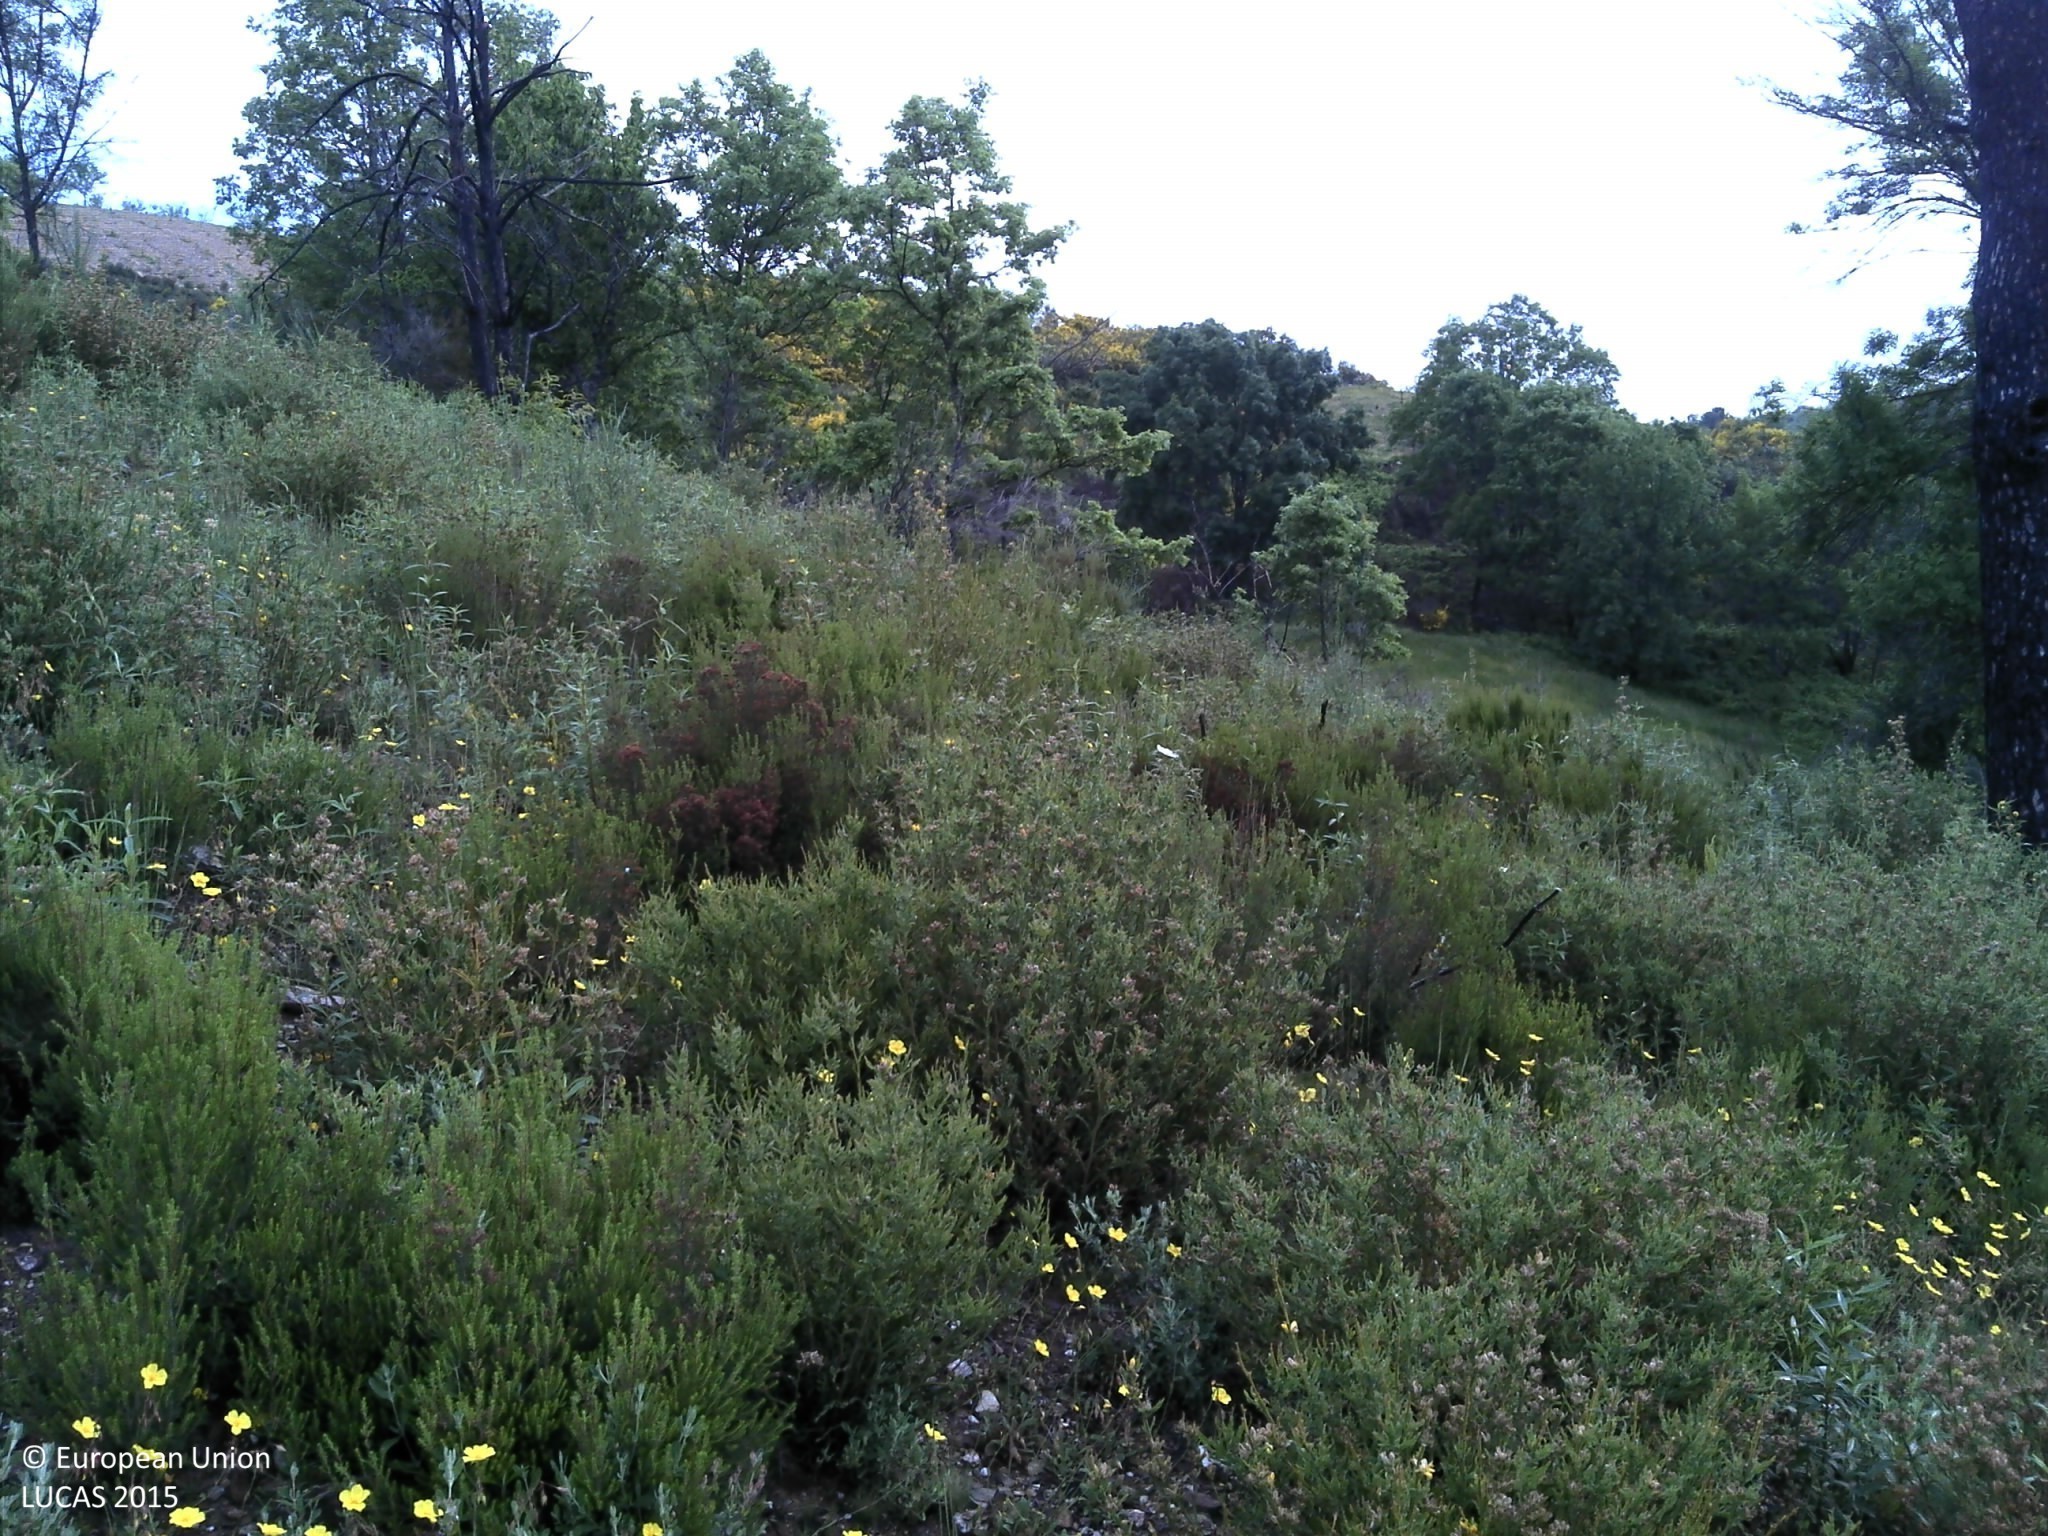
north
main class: Shrubland
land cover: Shrubland with sparse tree cover
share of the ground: > 75 %
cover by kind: shrubs 80 %, unconsolidated bare surface 15 %, broadleaved forest trees 5 %
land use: Forestry
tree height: < 5 m
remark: Burnt area
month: May
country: PT
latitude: 41.7677
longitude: -7.0447
